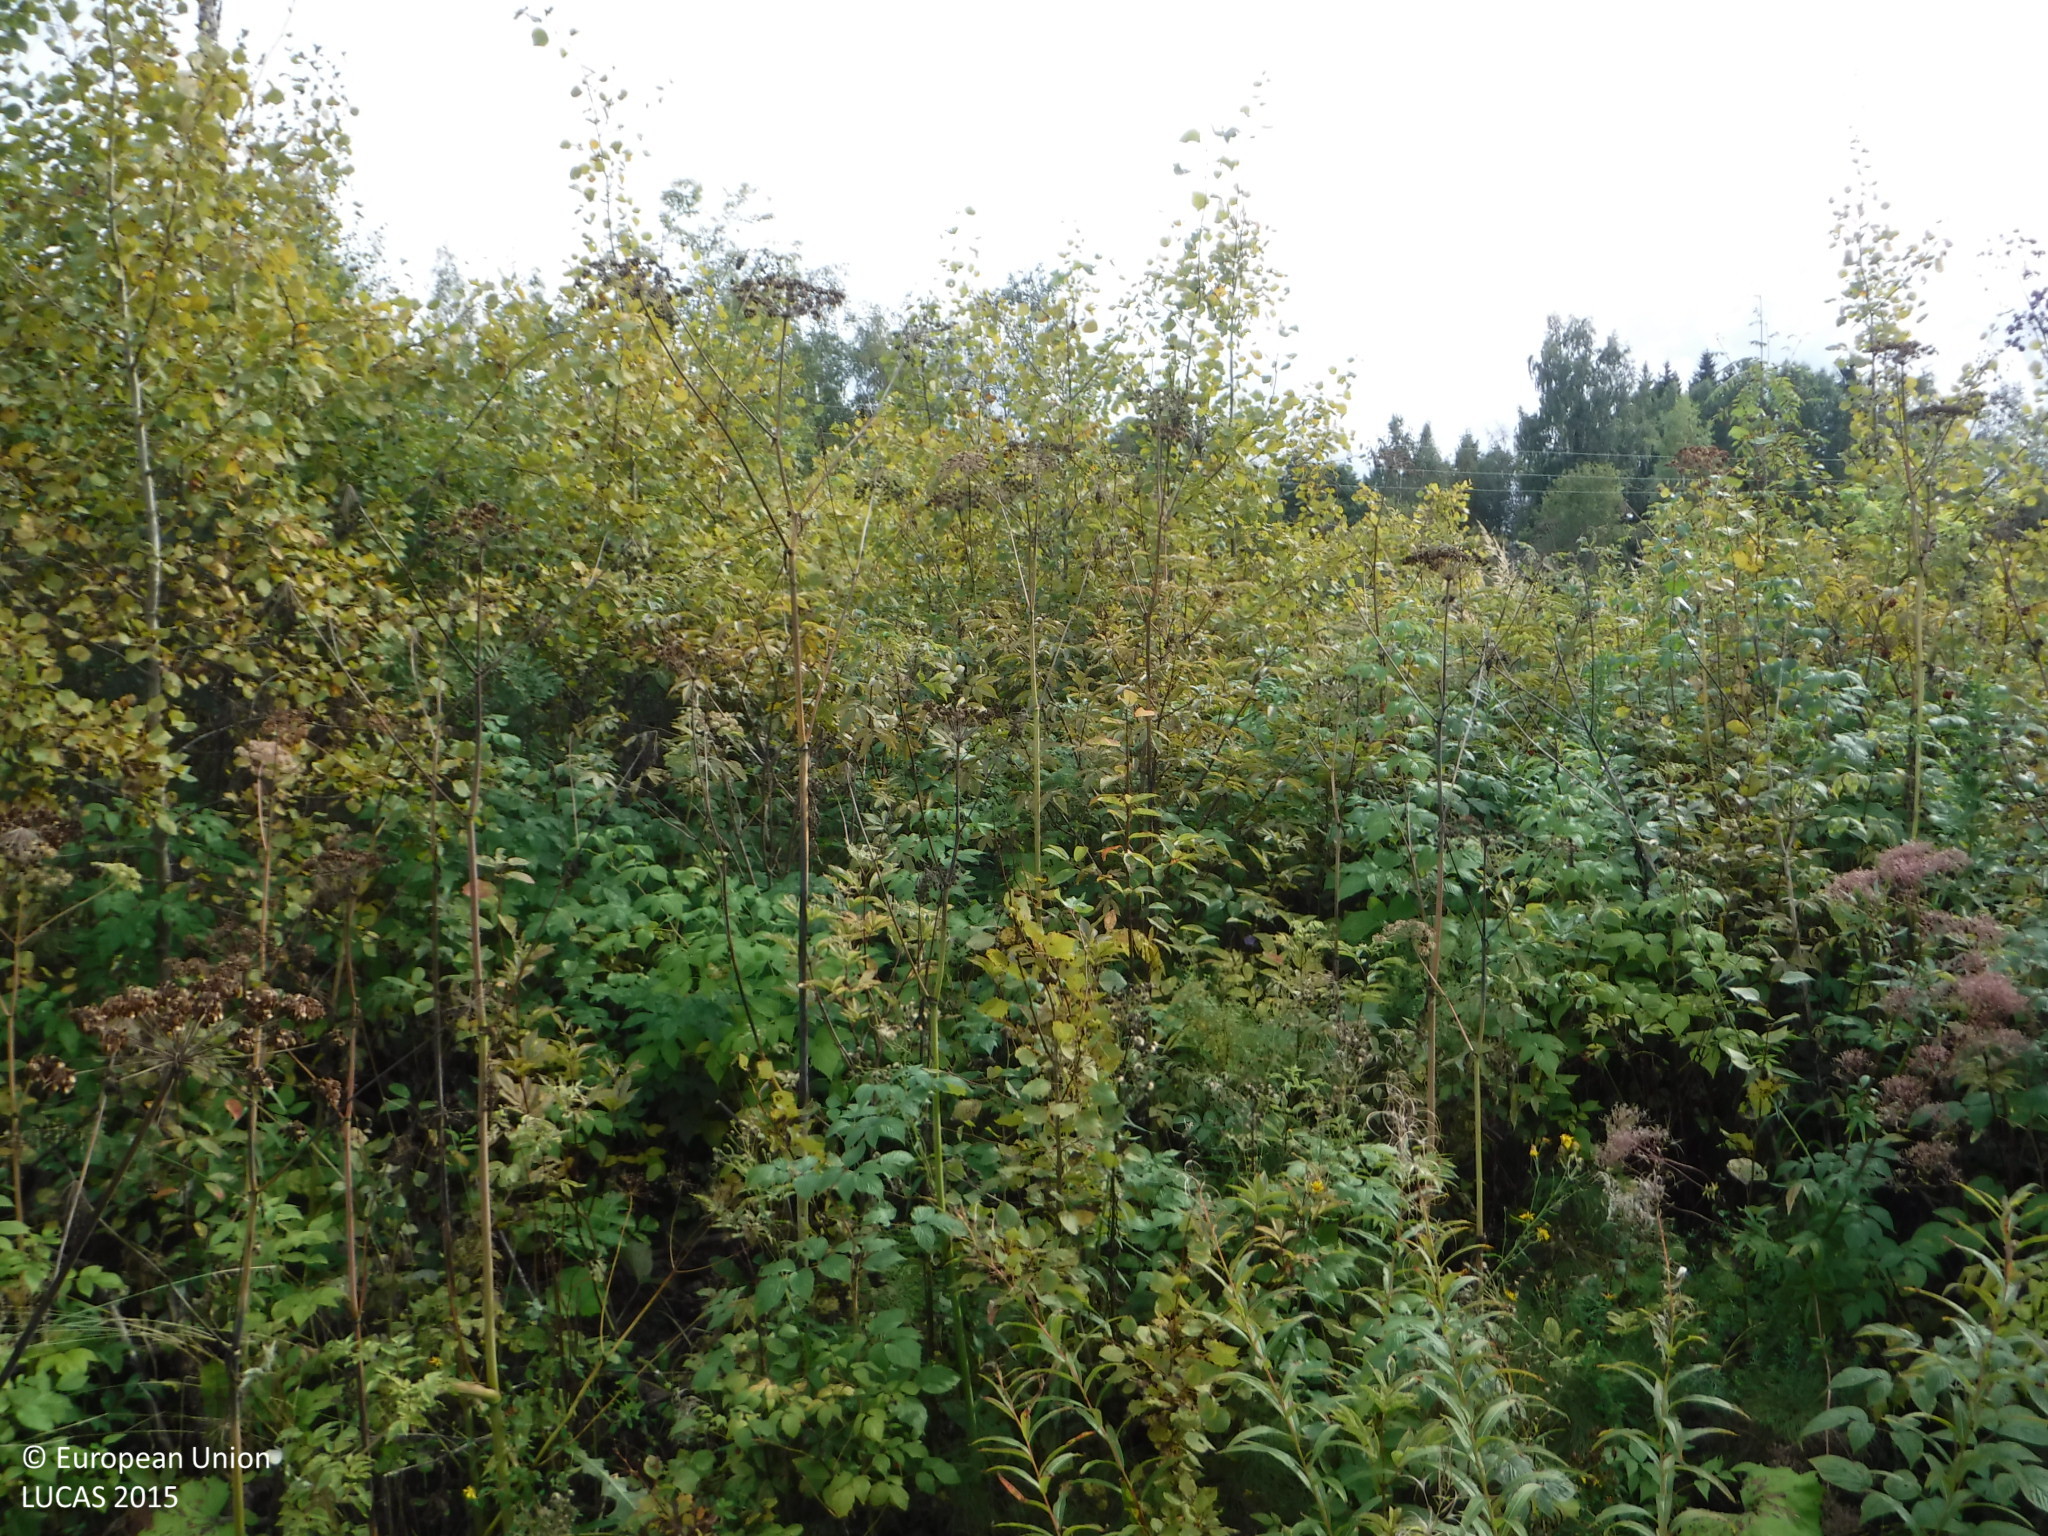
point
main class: Woodland
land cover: Broadleaved woodland
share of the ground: > 75 %
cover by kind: broadleaved forest trees 75 %, shrubs 20 %, herbaceous plants 5 %
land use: Semi-natural and natural areas not in use
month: September
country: FI
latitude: 61.4213
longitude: 23.0209
